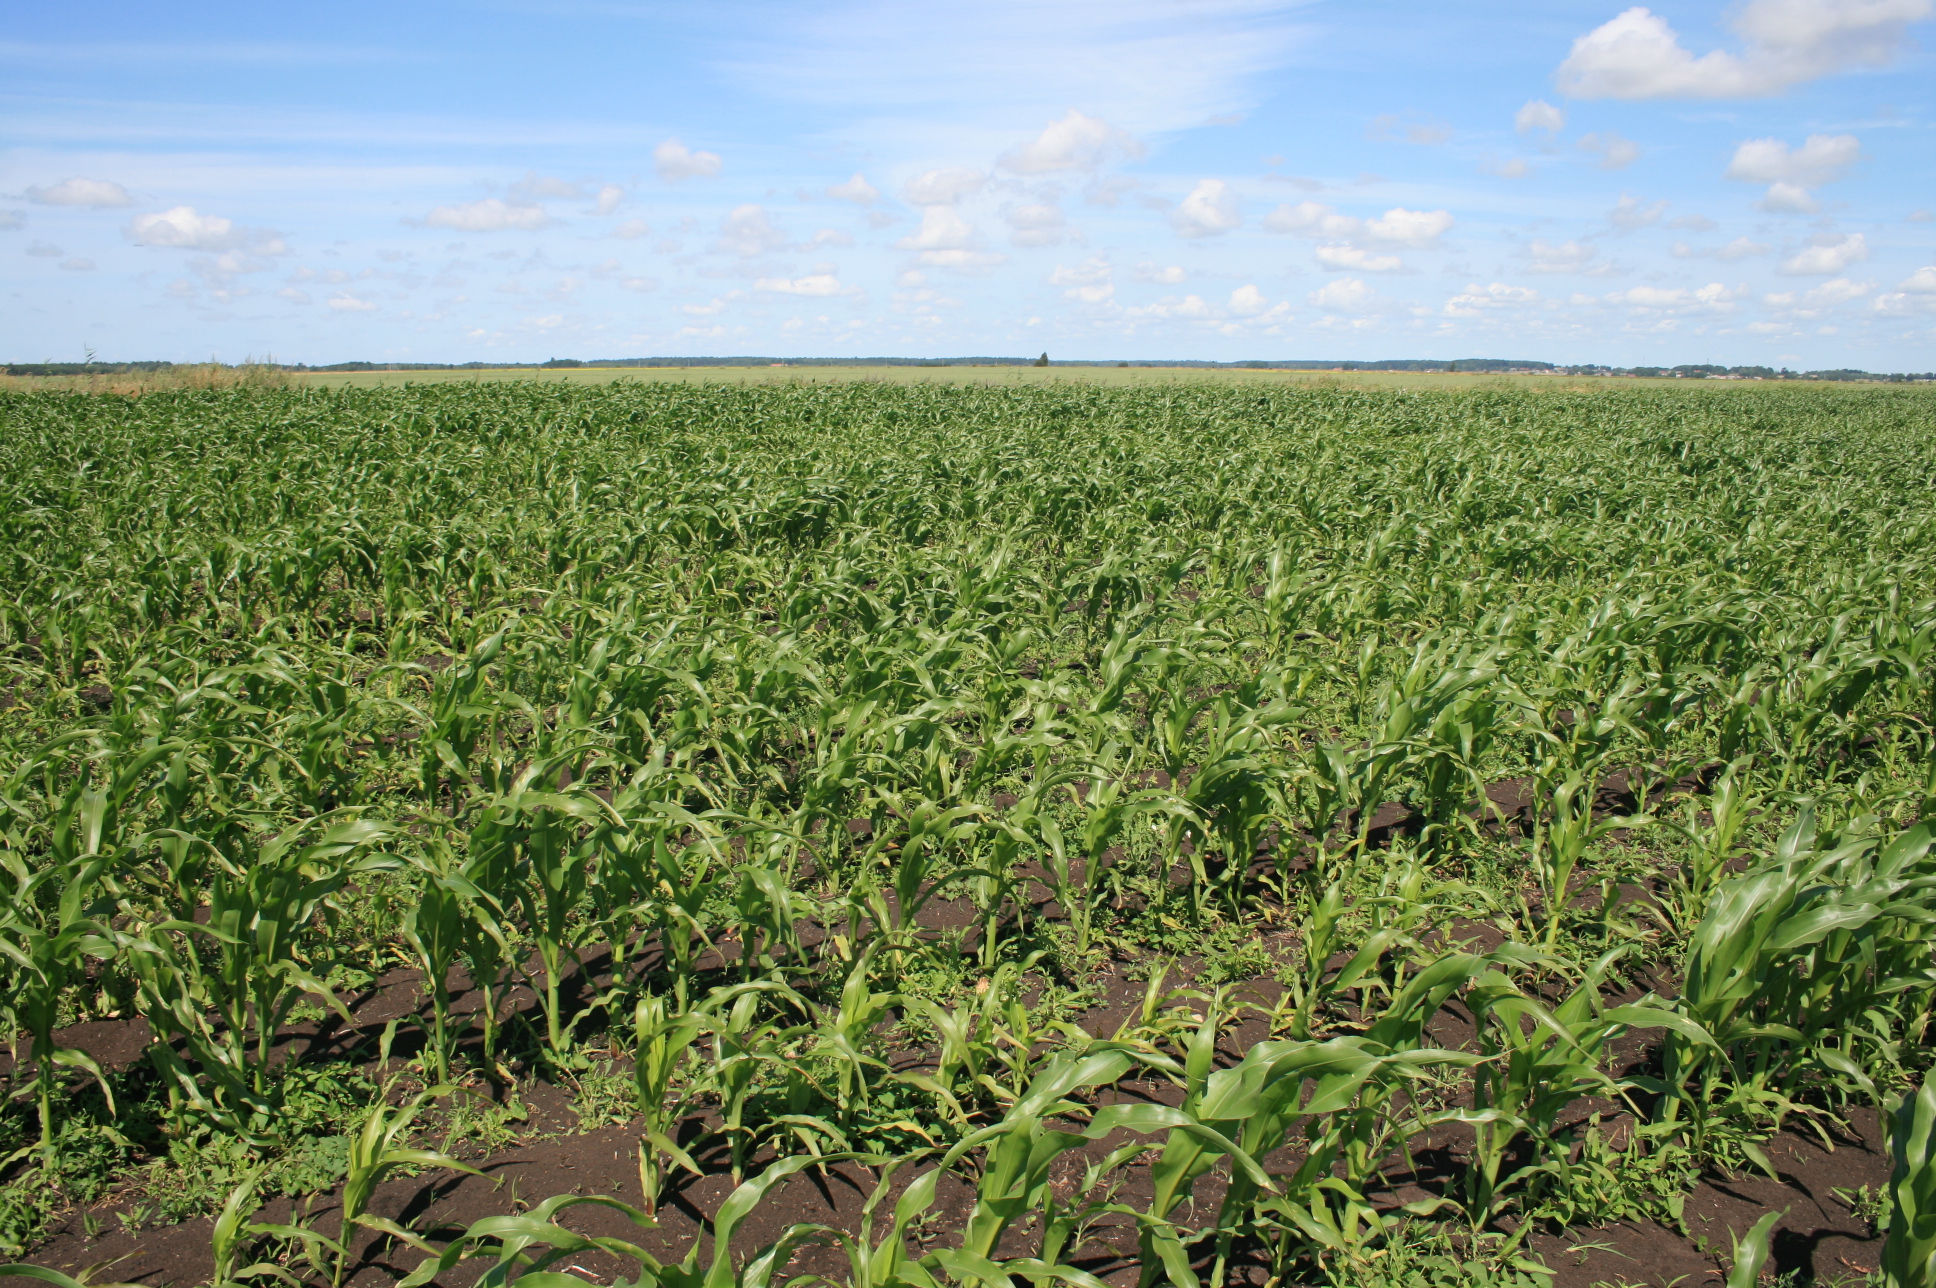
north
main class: Cropland
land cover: Maize
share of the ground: > 75 %
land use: Agriculture (excluding fallow land and kitchen gardens)
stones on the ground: < 10 %
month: July
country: LT
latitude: 55.5079
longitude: 21.2689
